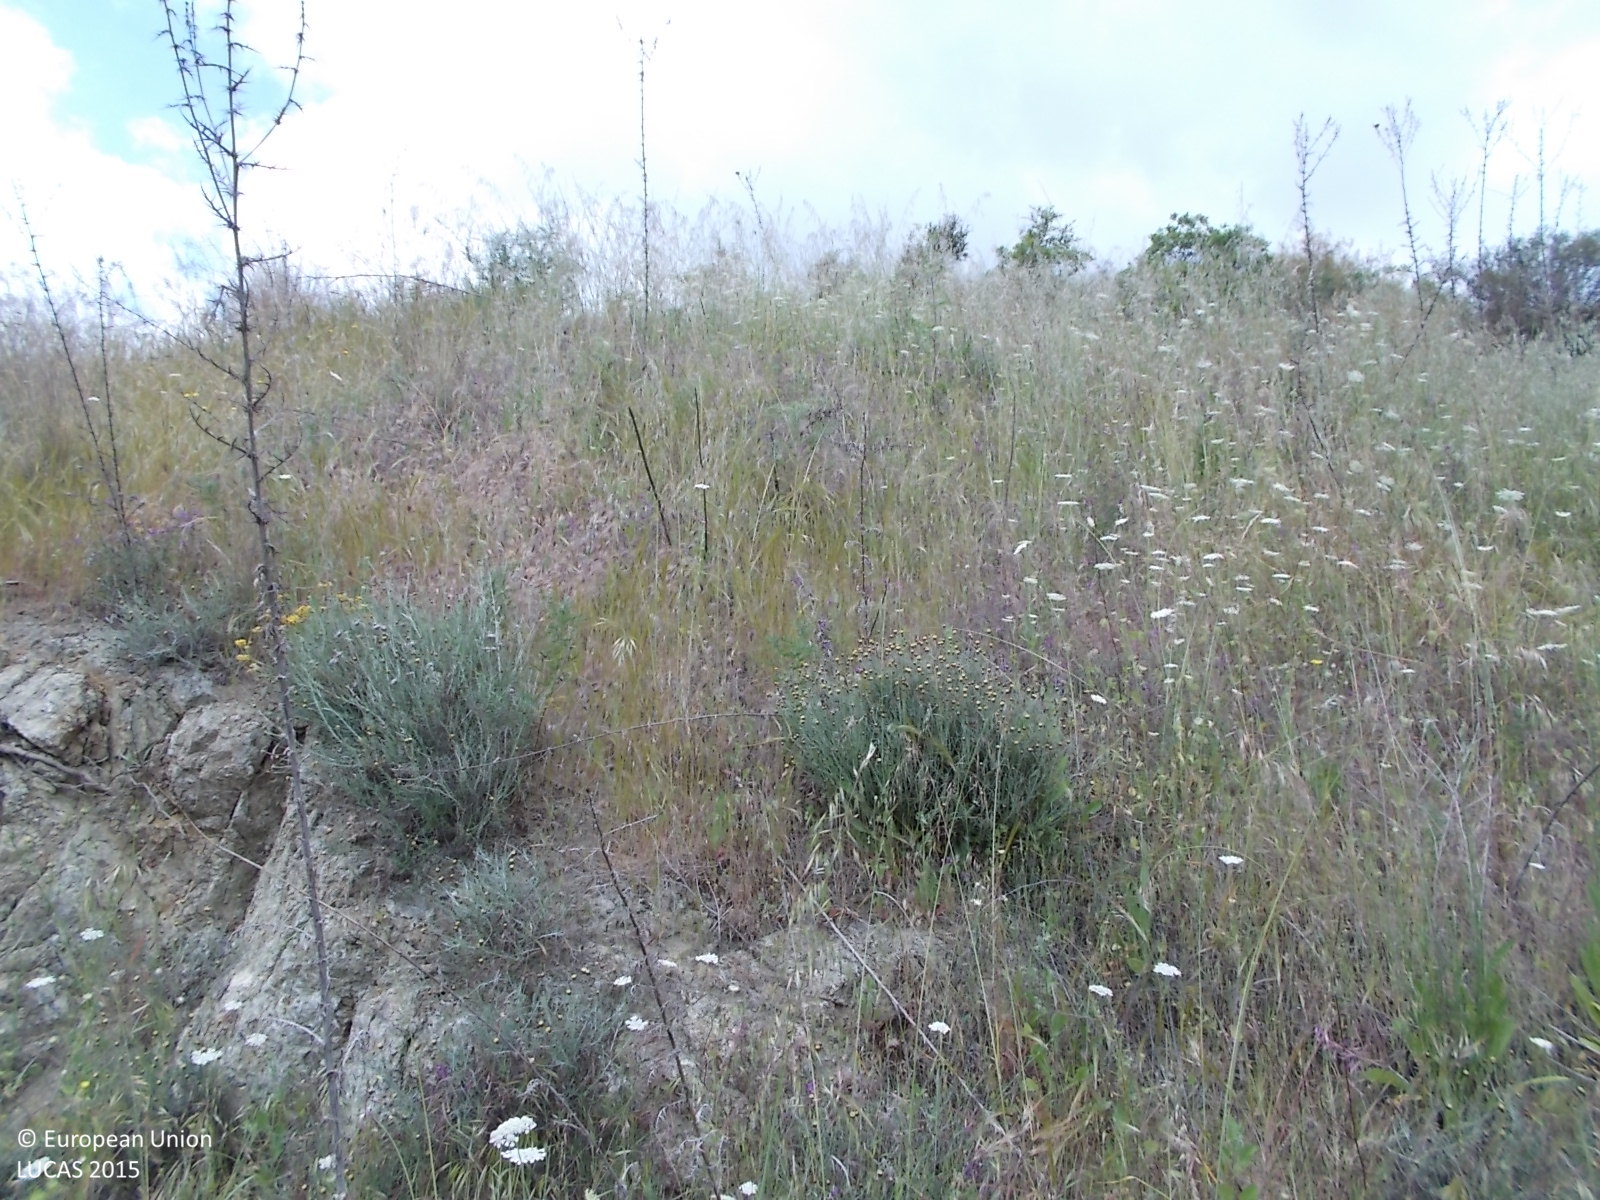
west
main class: Grassland
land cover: Spontaneously vegetated surfaces
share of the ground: > 75 %
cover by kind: herbaceous plants 100 %
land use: Fallow land
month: April
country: CY
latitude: 34.7966
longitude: 33.1358
